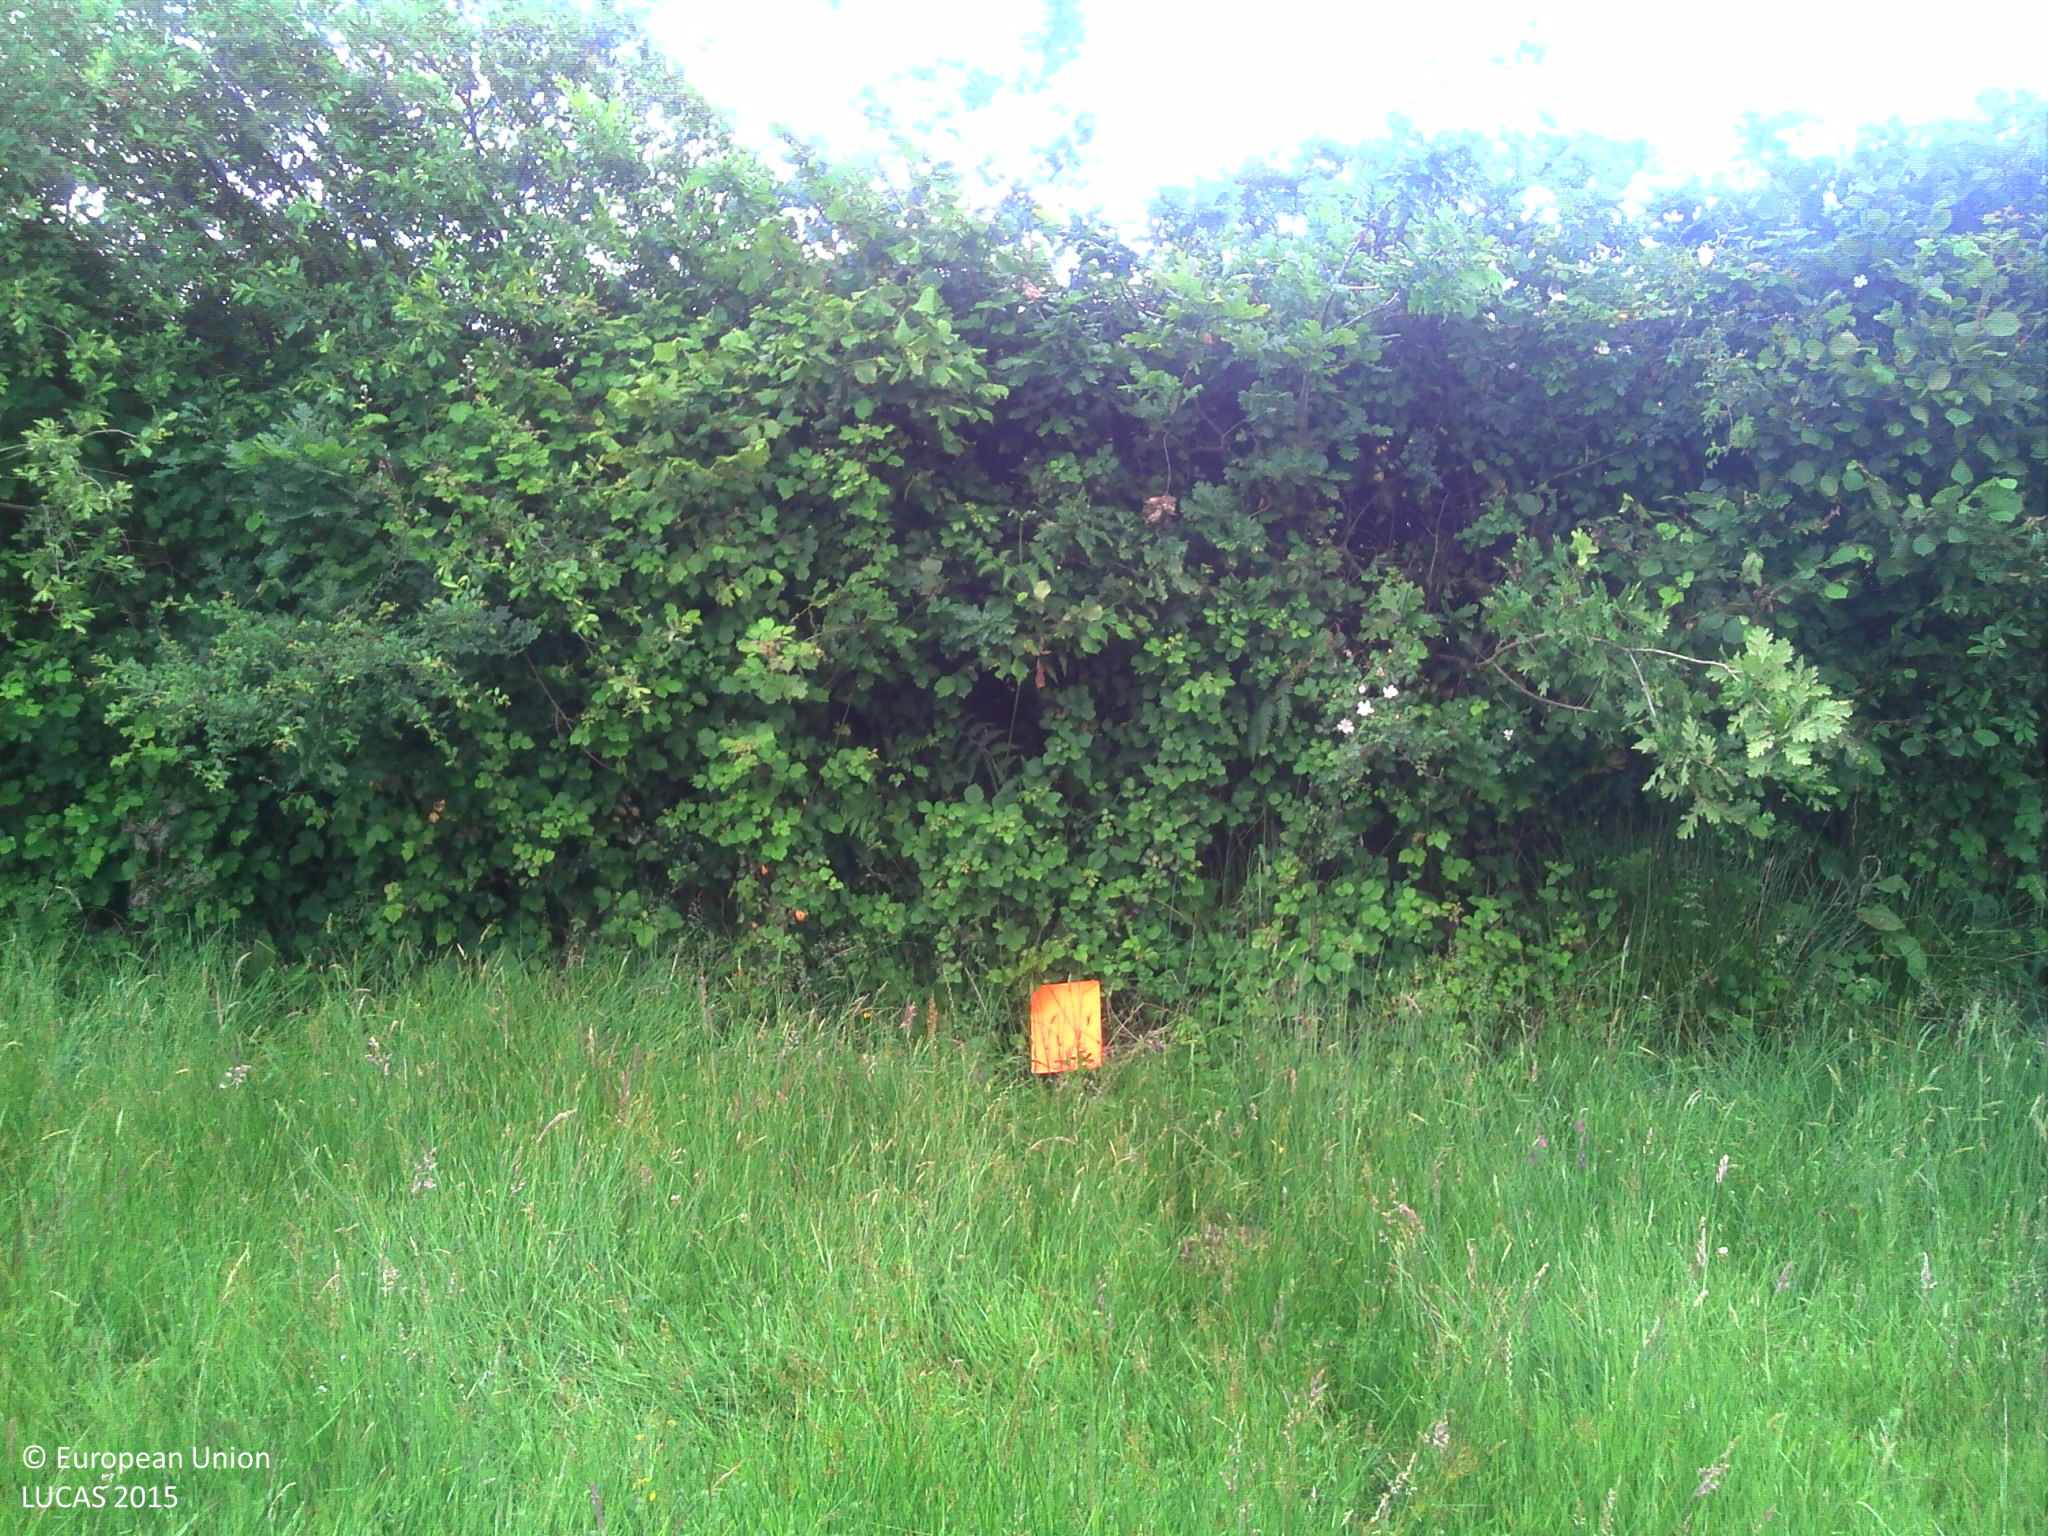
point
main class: Grassland
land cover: Grassland without tree/shrub cover
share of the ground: > 75 %
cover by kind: herbaceous plants 100 %
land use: Agriculture (excluding fallow land and kitchen gardens)
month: June
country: FR
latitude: 49.3982
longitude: -1.6955
